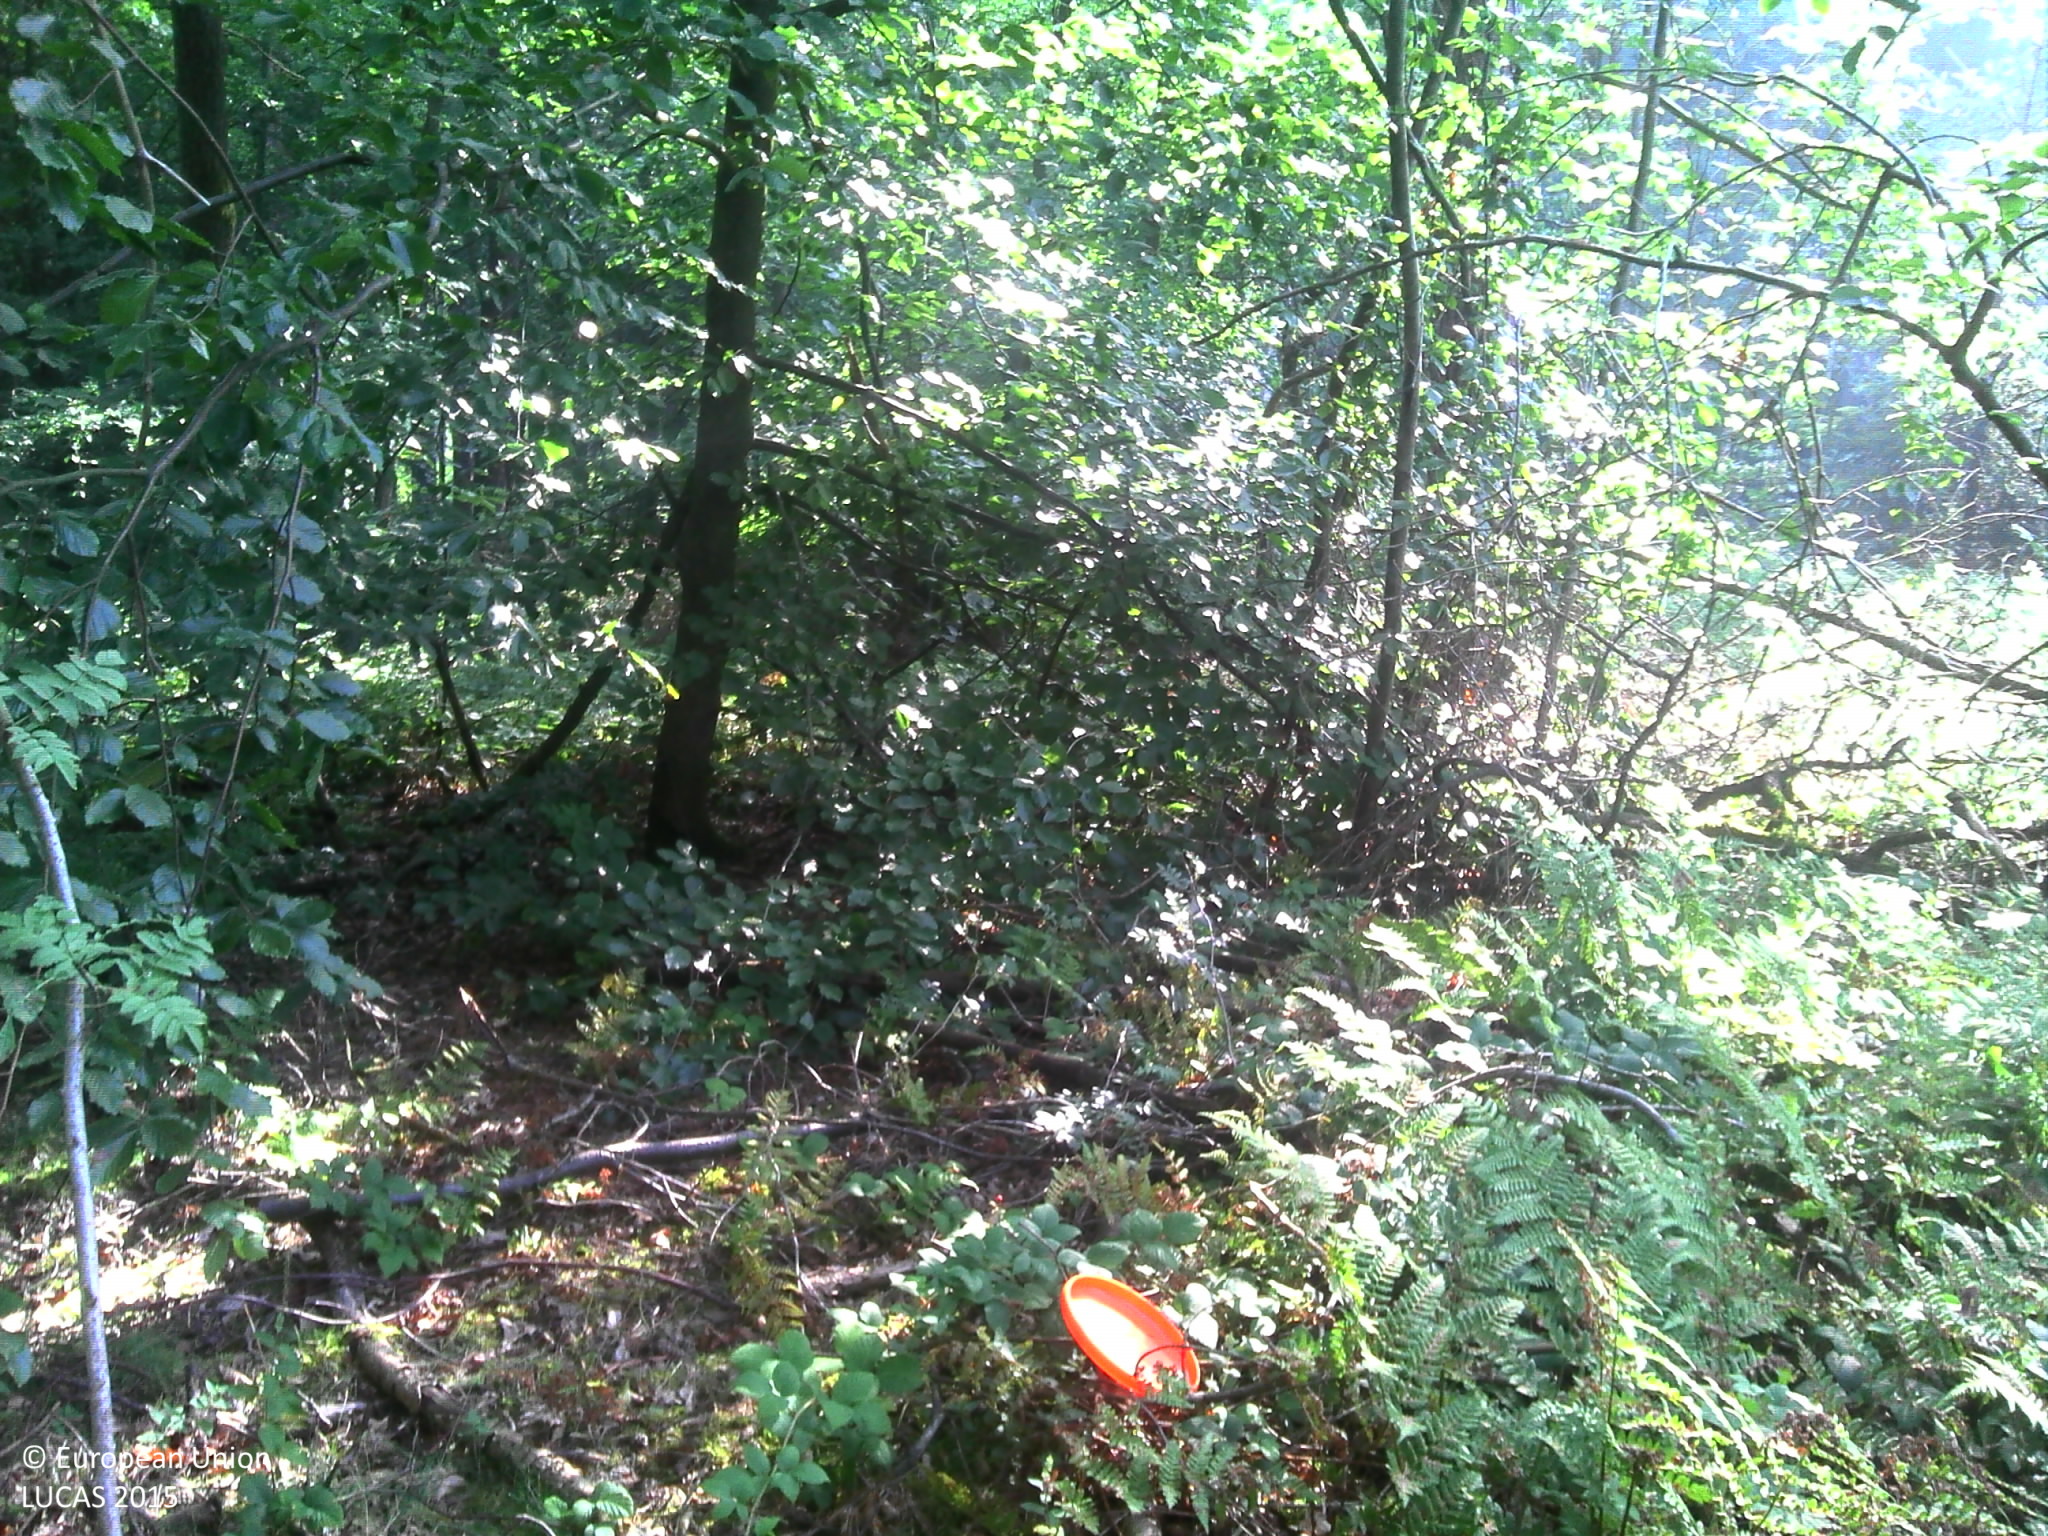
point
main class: Woodland
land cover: Pine dominated mixed woodland
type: hemiboreal forest and nemoral coniferous forest and mixed broadleaved-coniferous forest
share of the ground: > 75 %
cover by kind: coniferous forest trees 50 %, broadleaved forest trees 30 %, herbaceous plants 20 %
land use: Forestry
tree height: > 5 m
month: August
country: BE
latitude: 50.3314
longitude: 5.5450
